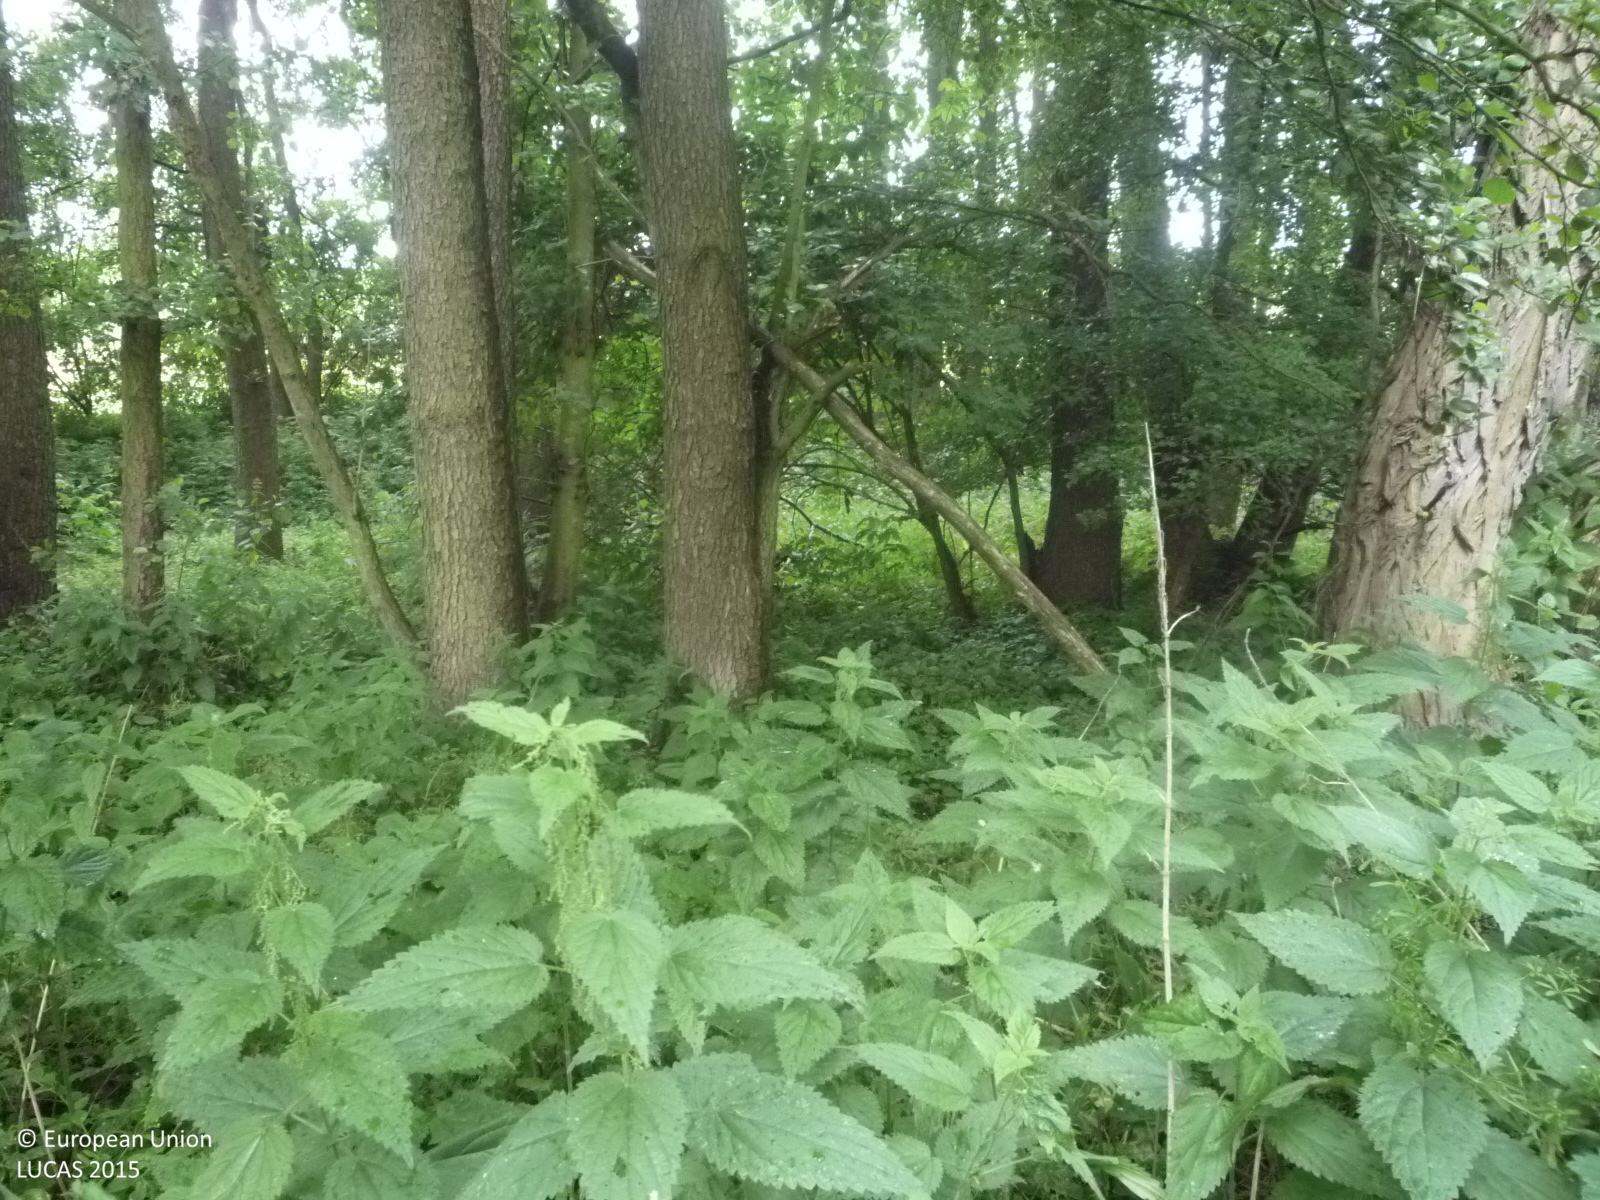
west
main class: Woodland
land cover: Broadleaved woodland
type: floodplain forest
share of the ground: > 75 %
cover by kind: broadleaved forest trees 50 %, herbaceous plants 40 %, shrubs 10 %
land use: Semi-natural and natural areas not in use
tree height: > 5 m
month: July
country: CZ
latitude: 50.4393
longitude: 15.6790
